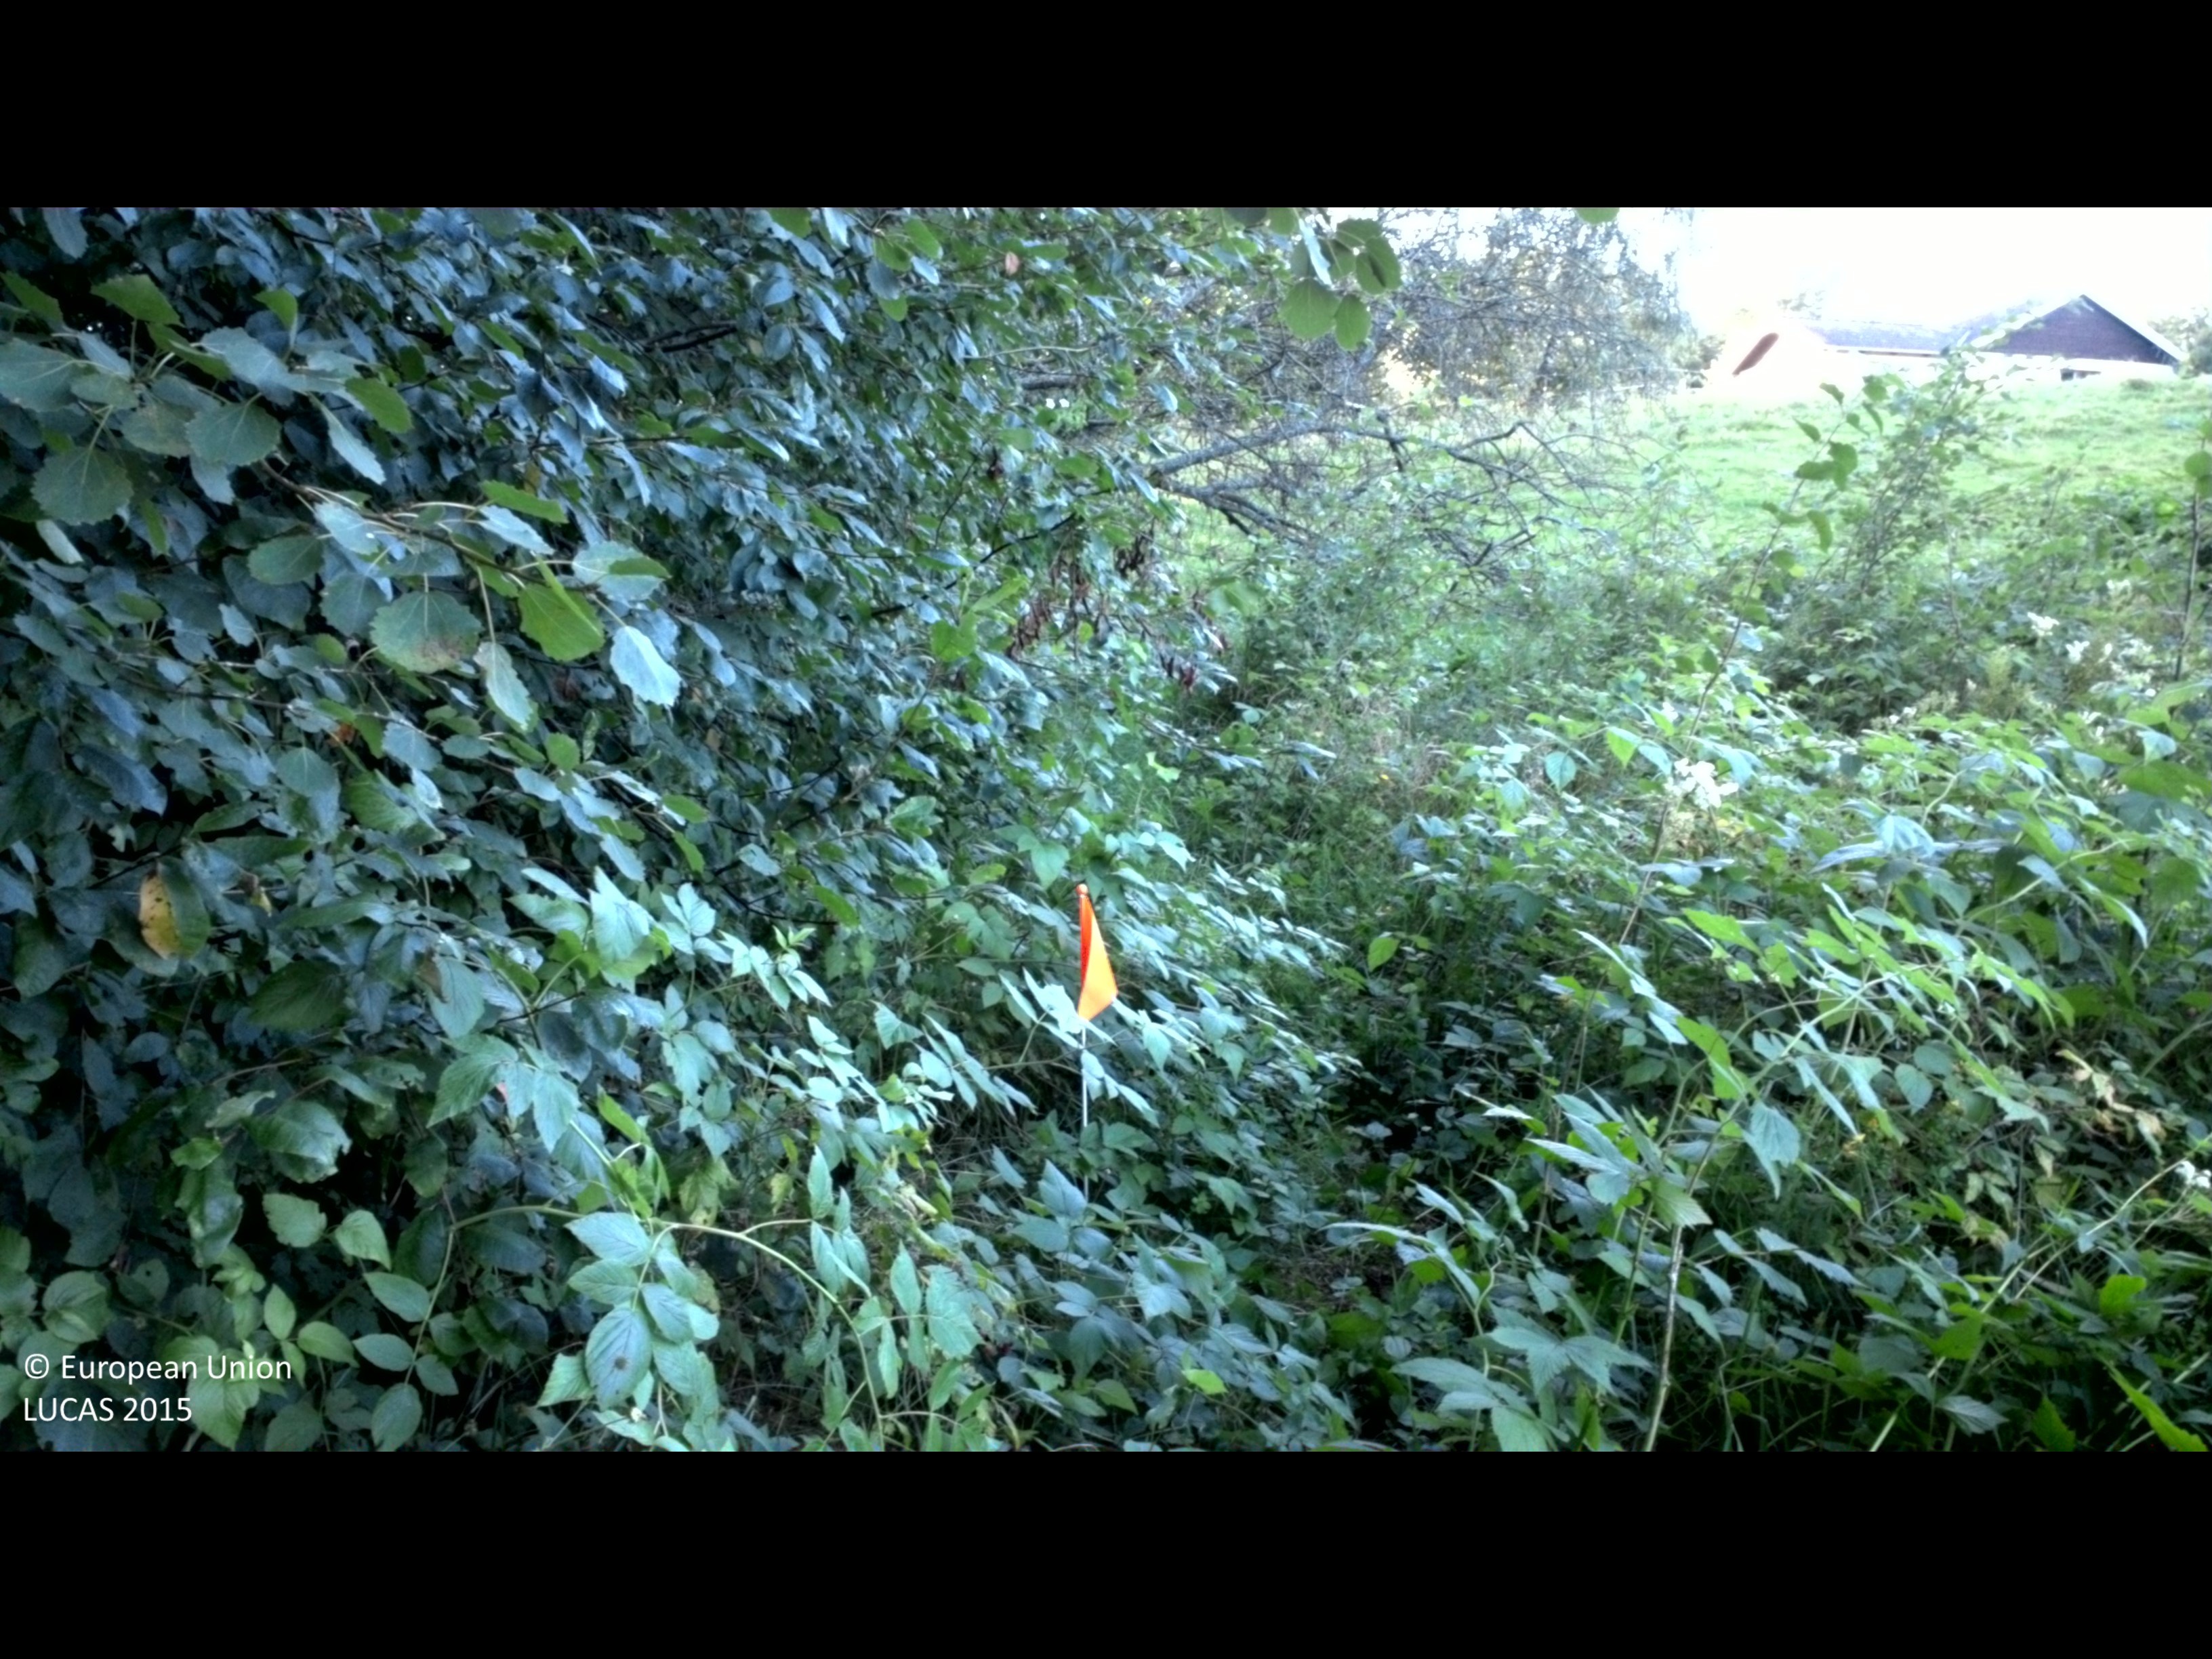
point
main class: Woodland
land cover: Broadleaved woodland
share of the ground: 50 - 75 %
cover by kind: broadleaved forest trees 60 %, shrubs 40 %
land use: Semi-natural and natural areas not in use
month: August
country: SE
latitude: 57.0106
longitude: 13.2404
